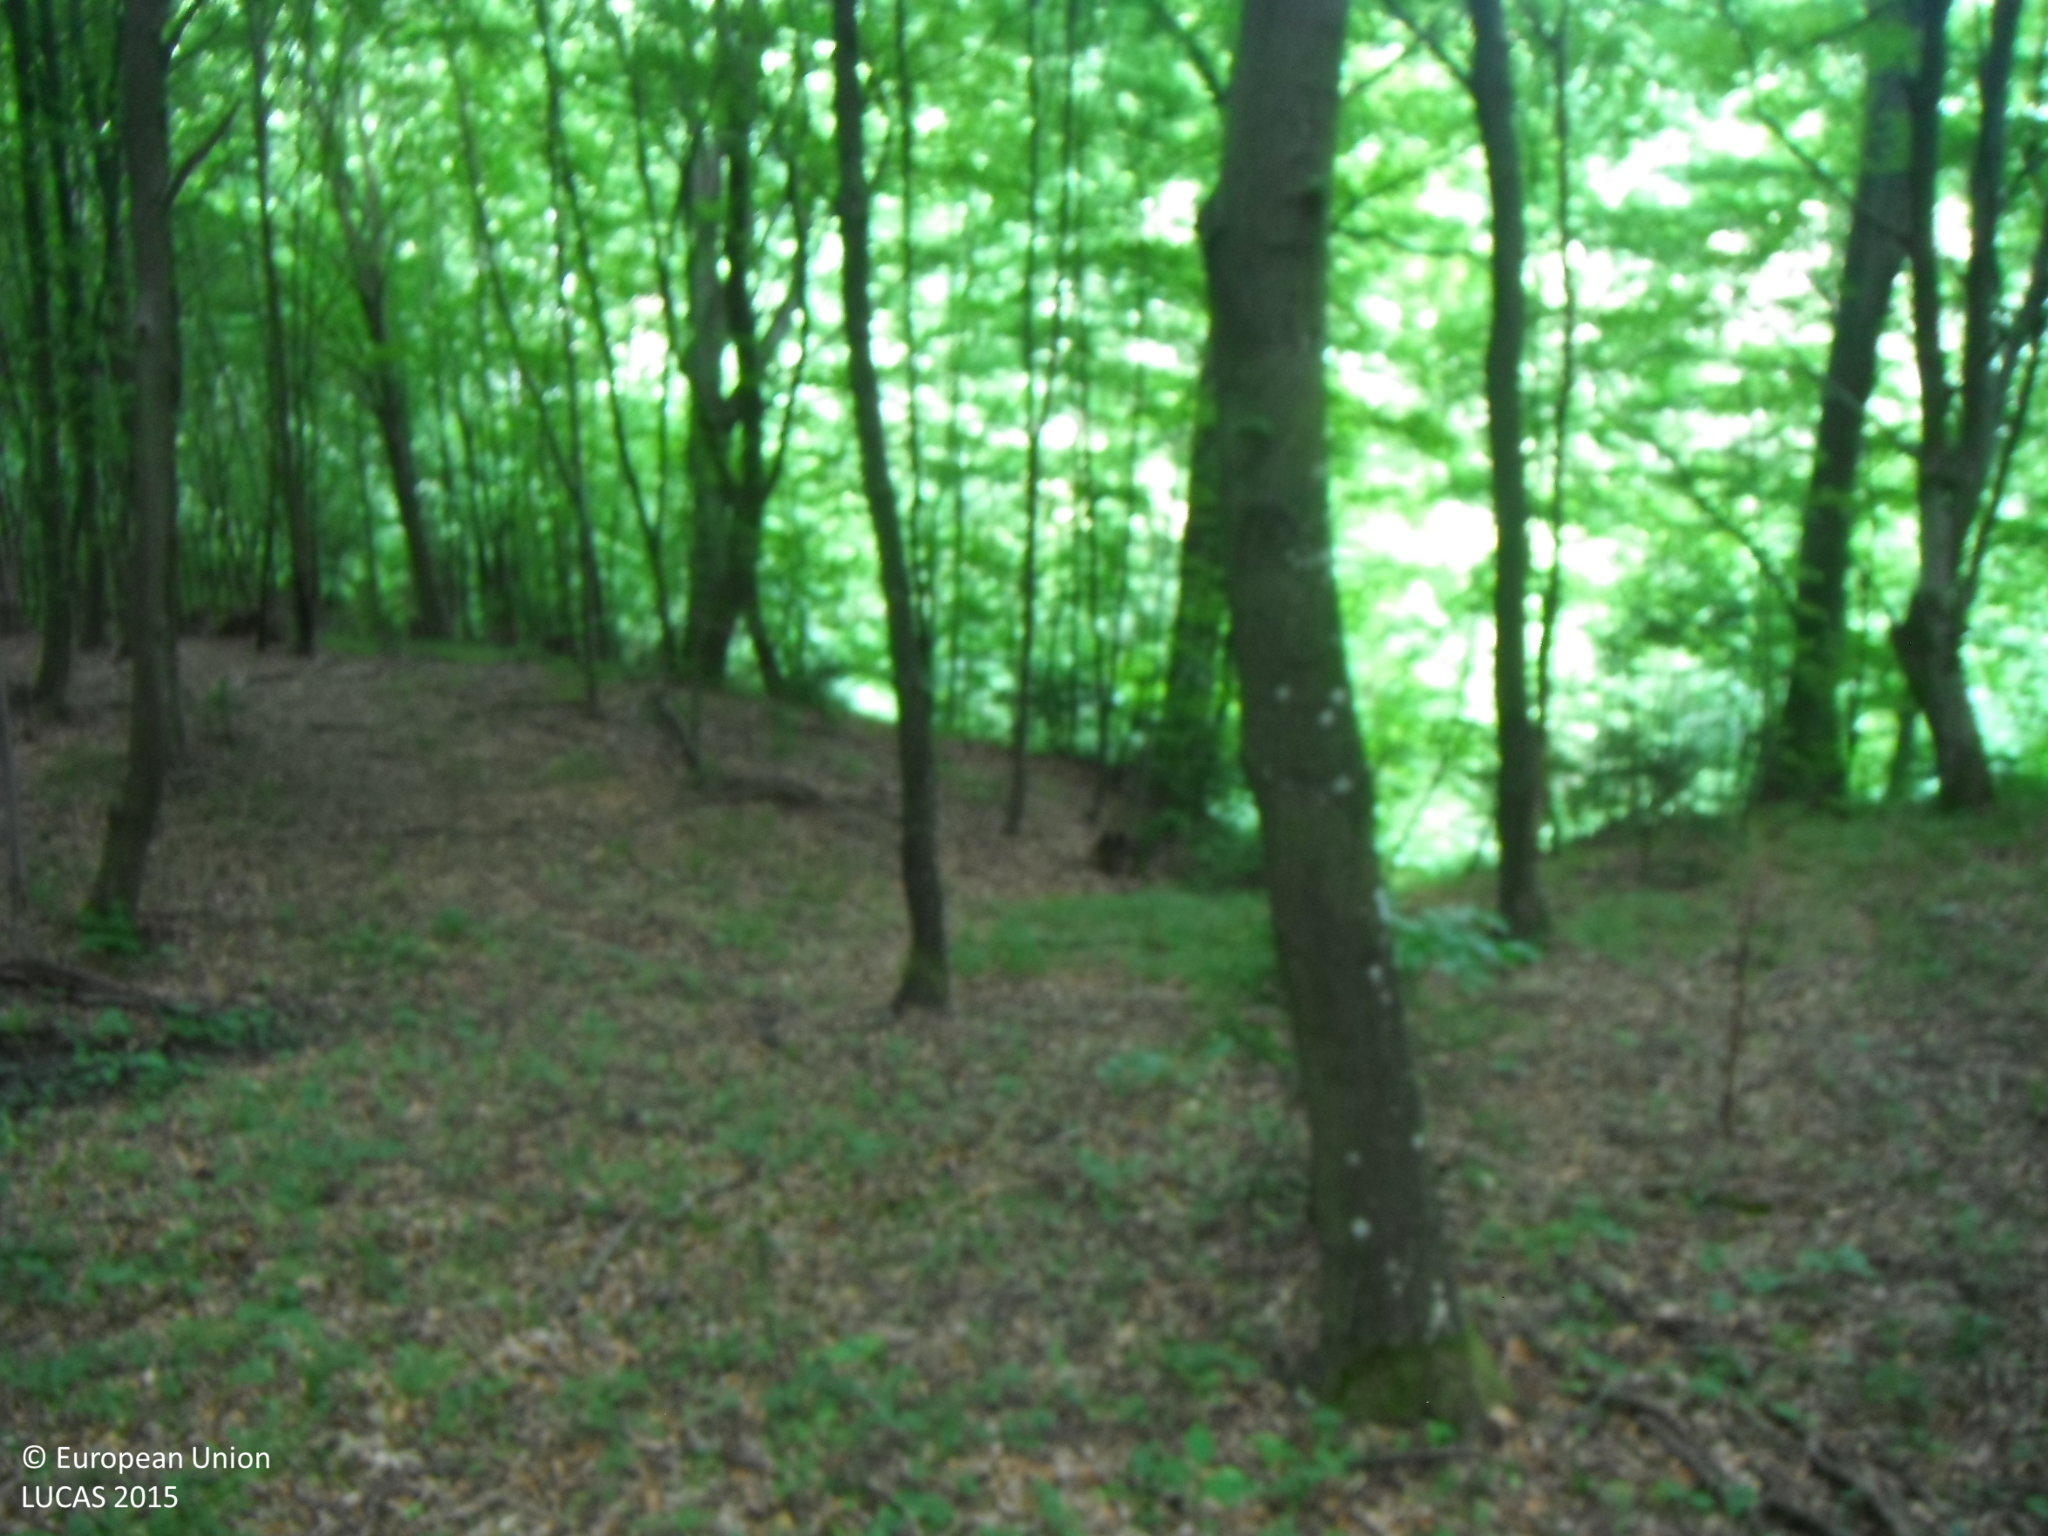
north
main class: Woodland
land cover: Broadleaved woodland
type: beech forest
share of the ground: > 75 %
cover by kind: broadleaved forest trees 100 %
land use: Forestry
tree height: > 5 m
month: June
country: SK
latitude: 48.9087
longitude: 22.3538
